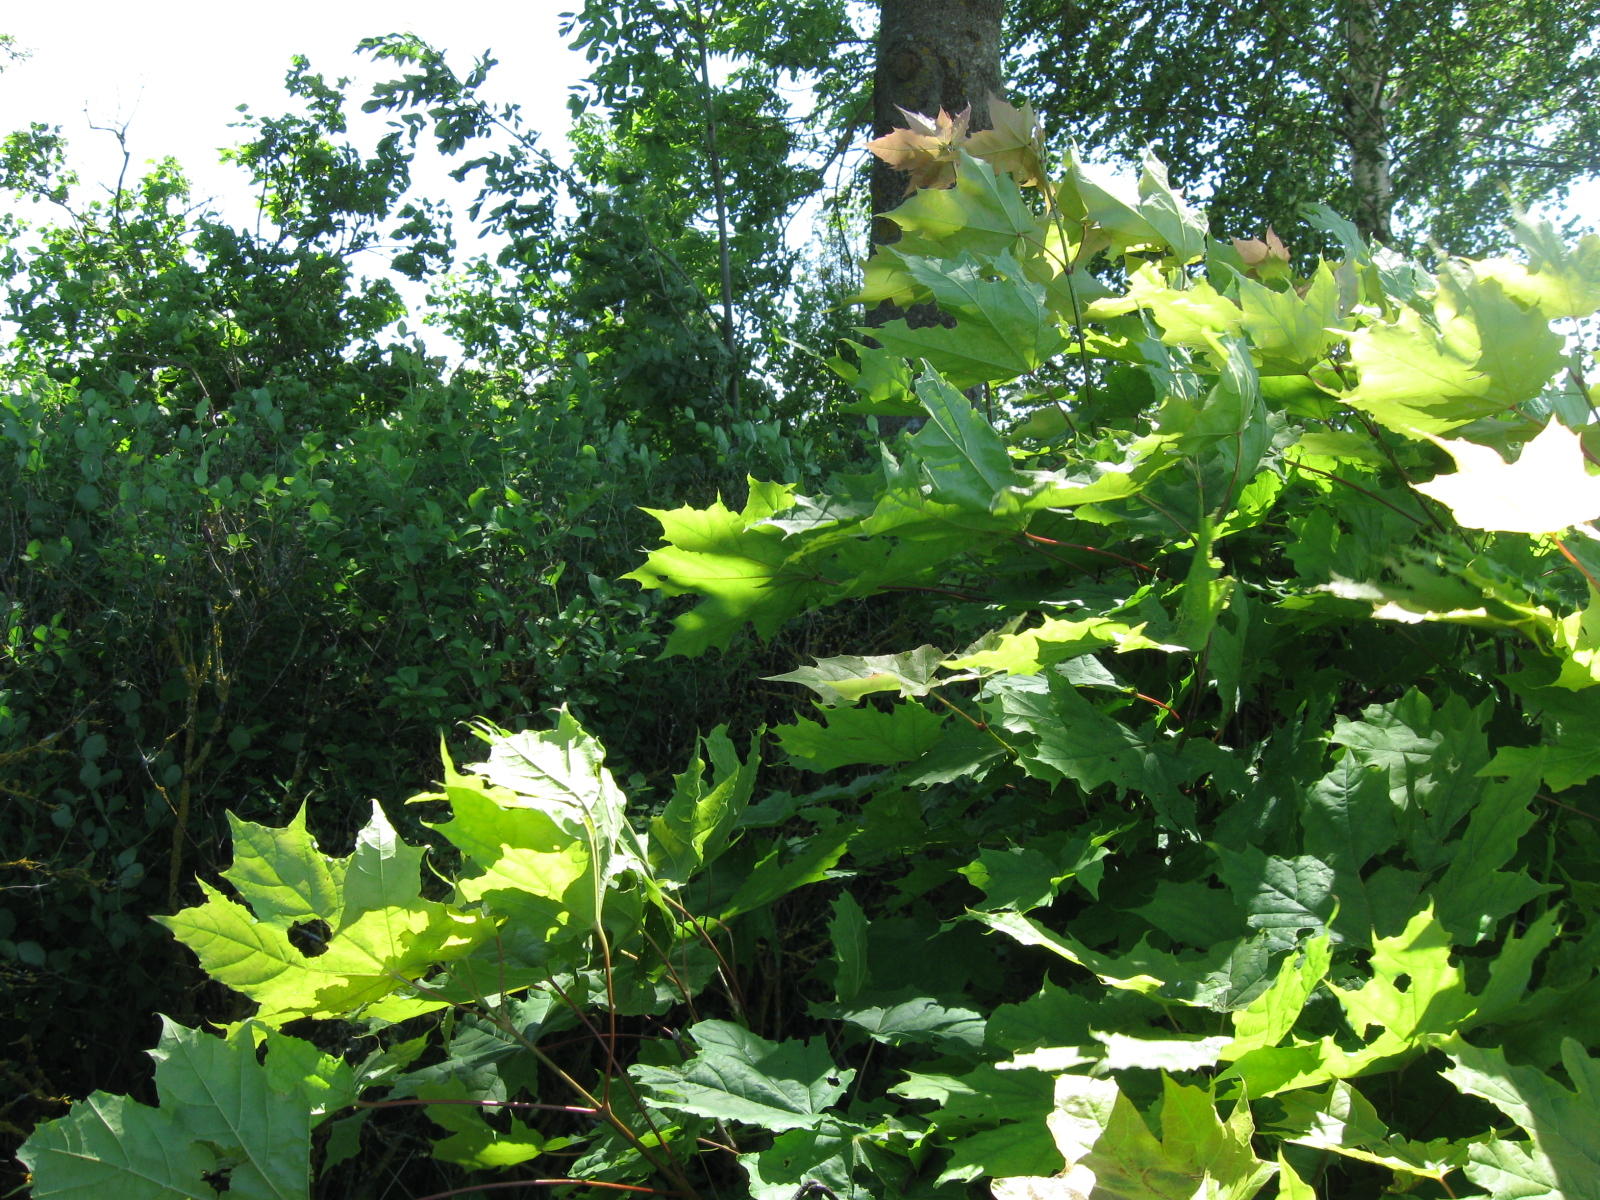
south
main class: Cropland
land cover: Apple fruit
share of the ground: 50 - 75 %
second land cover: Shrubland without tree cover
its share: 50 - 75 %
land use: Kitchen garden
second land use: Residential
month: June
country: LT
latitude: 54.3913
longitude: 23.8417
